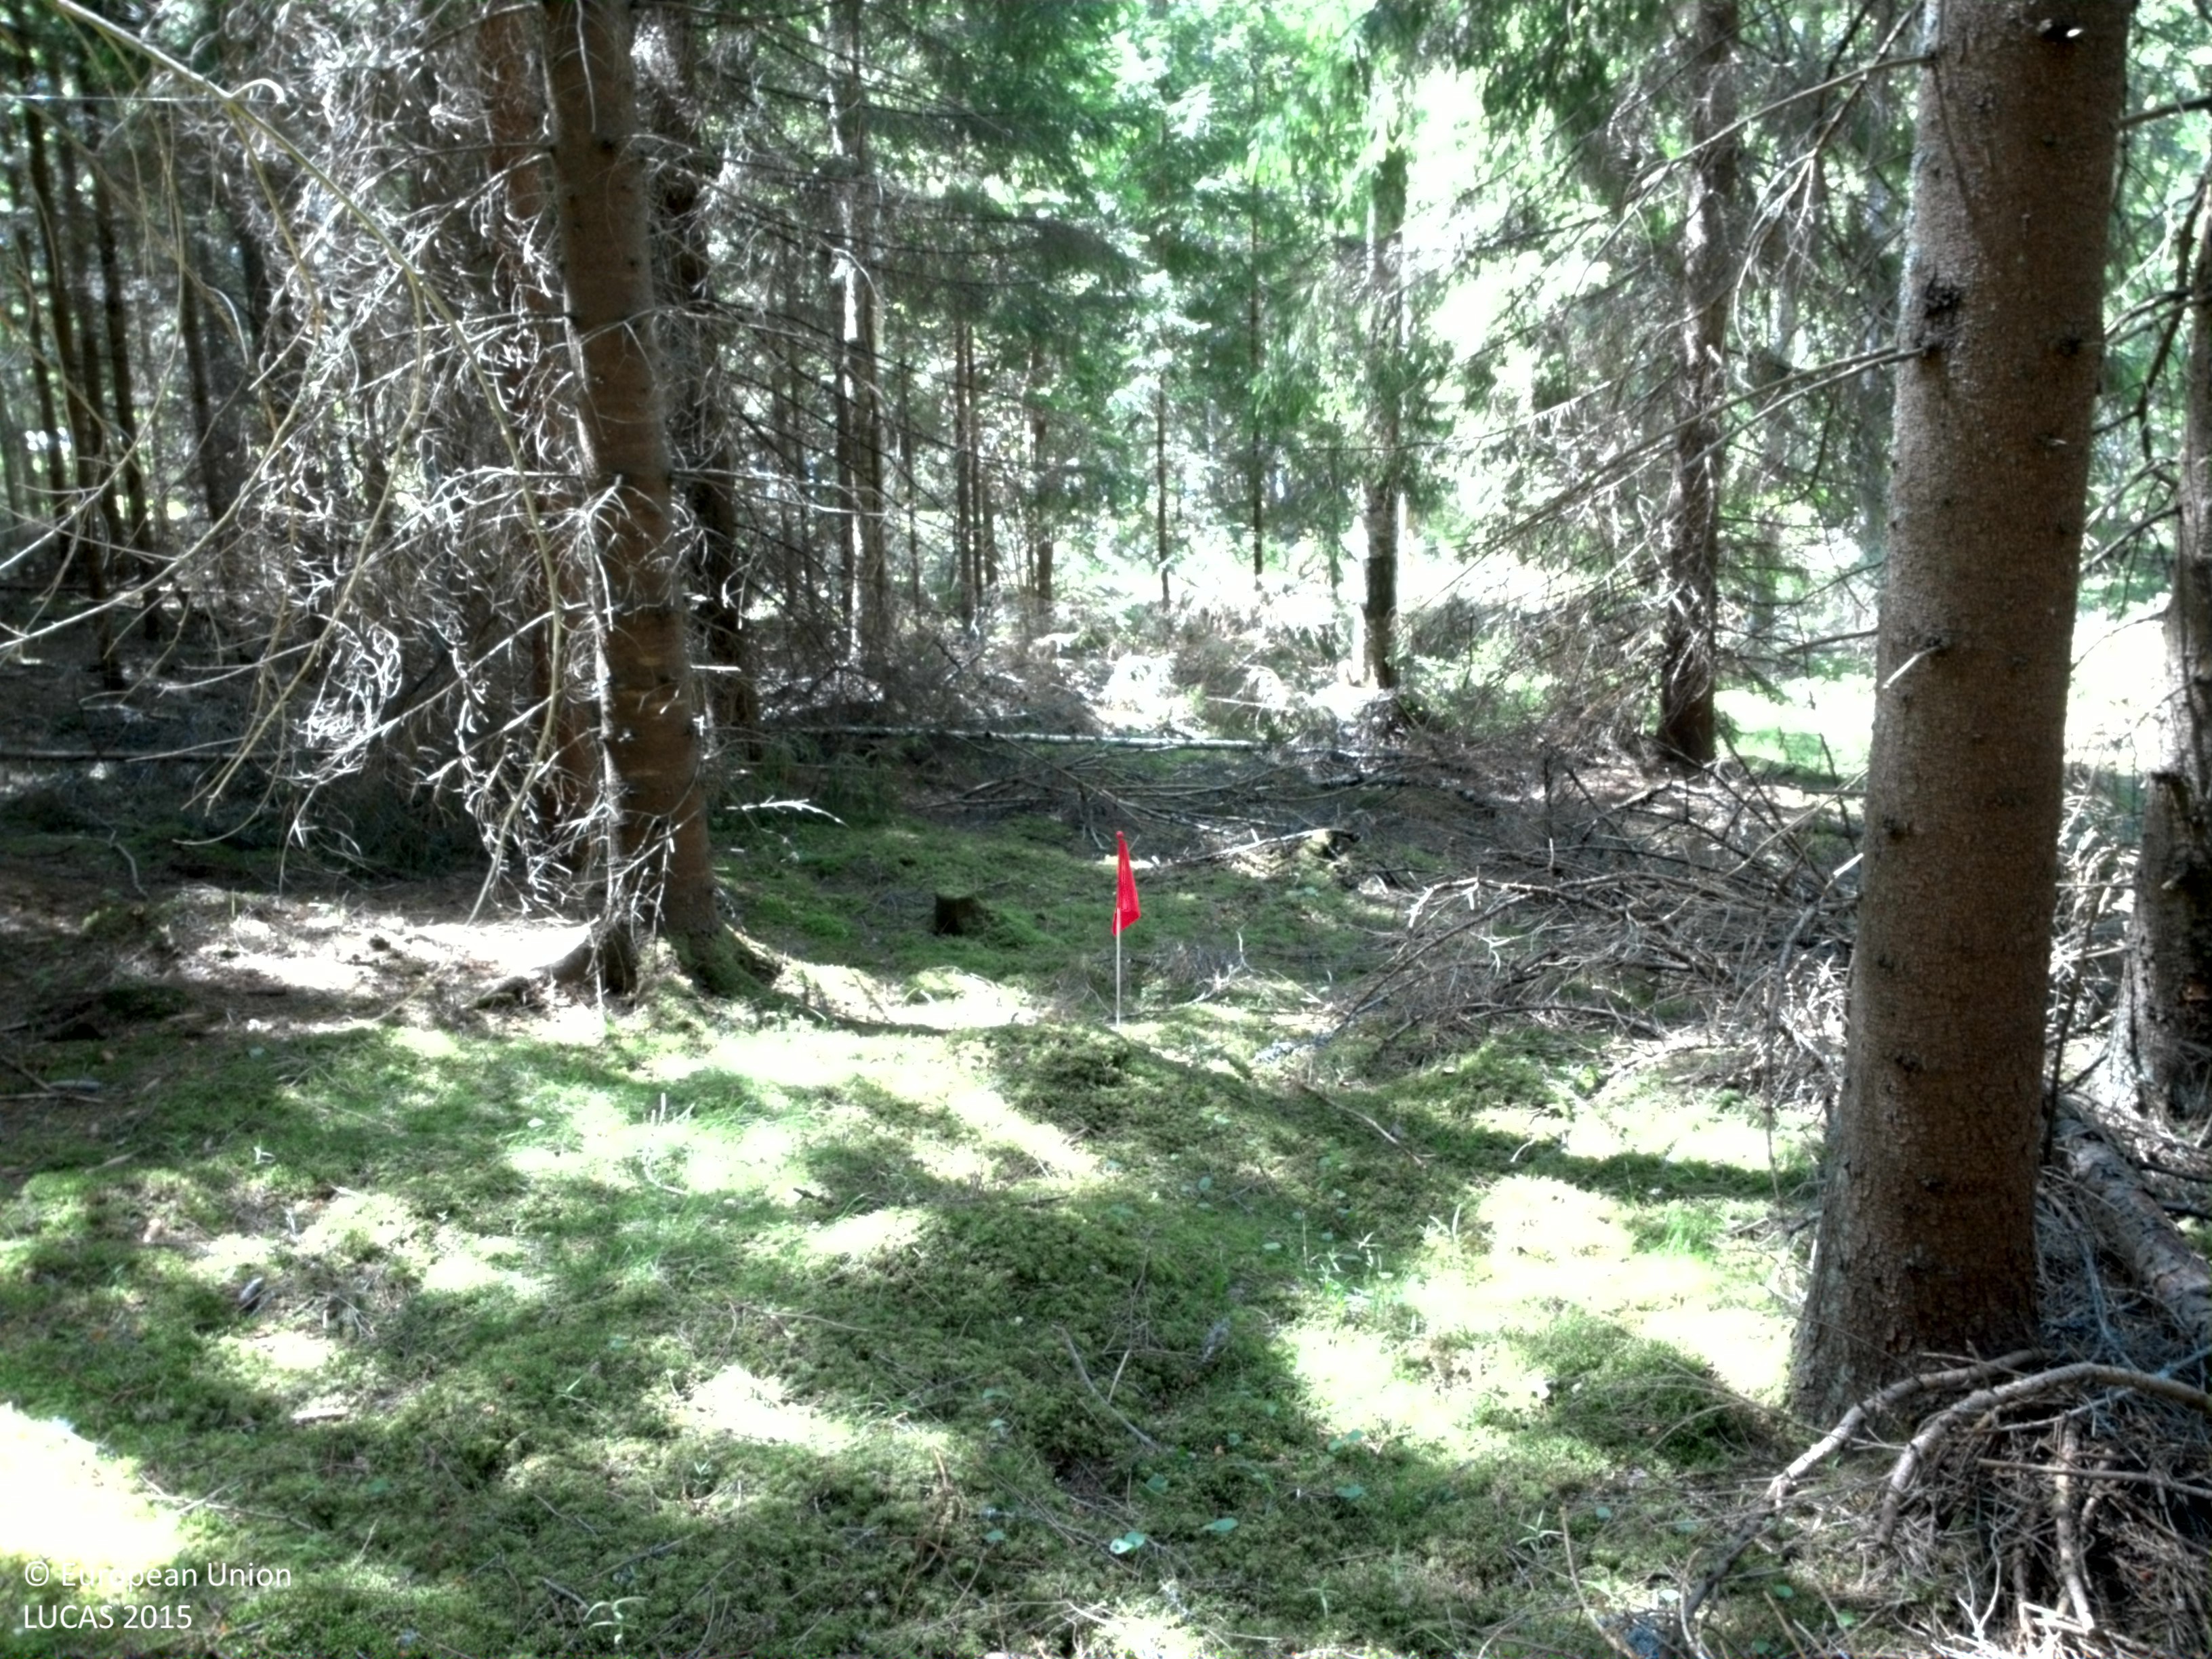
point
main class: Woodland
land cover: Spruce dominated coniferous woodland
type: boreal forest
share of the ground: 50 - 75 %
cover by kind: coniferous forest trees 75 %, lichens and mosses 25 %
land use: Forestry
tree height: > 5 m
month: June
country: SE
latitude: 58.5593
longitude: 14.4795
